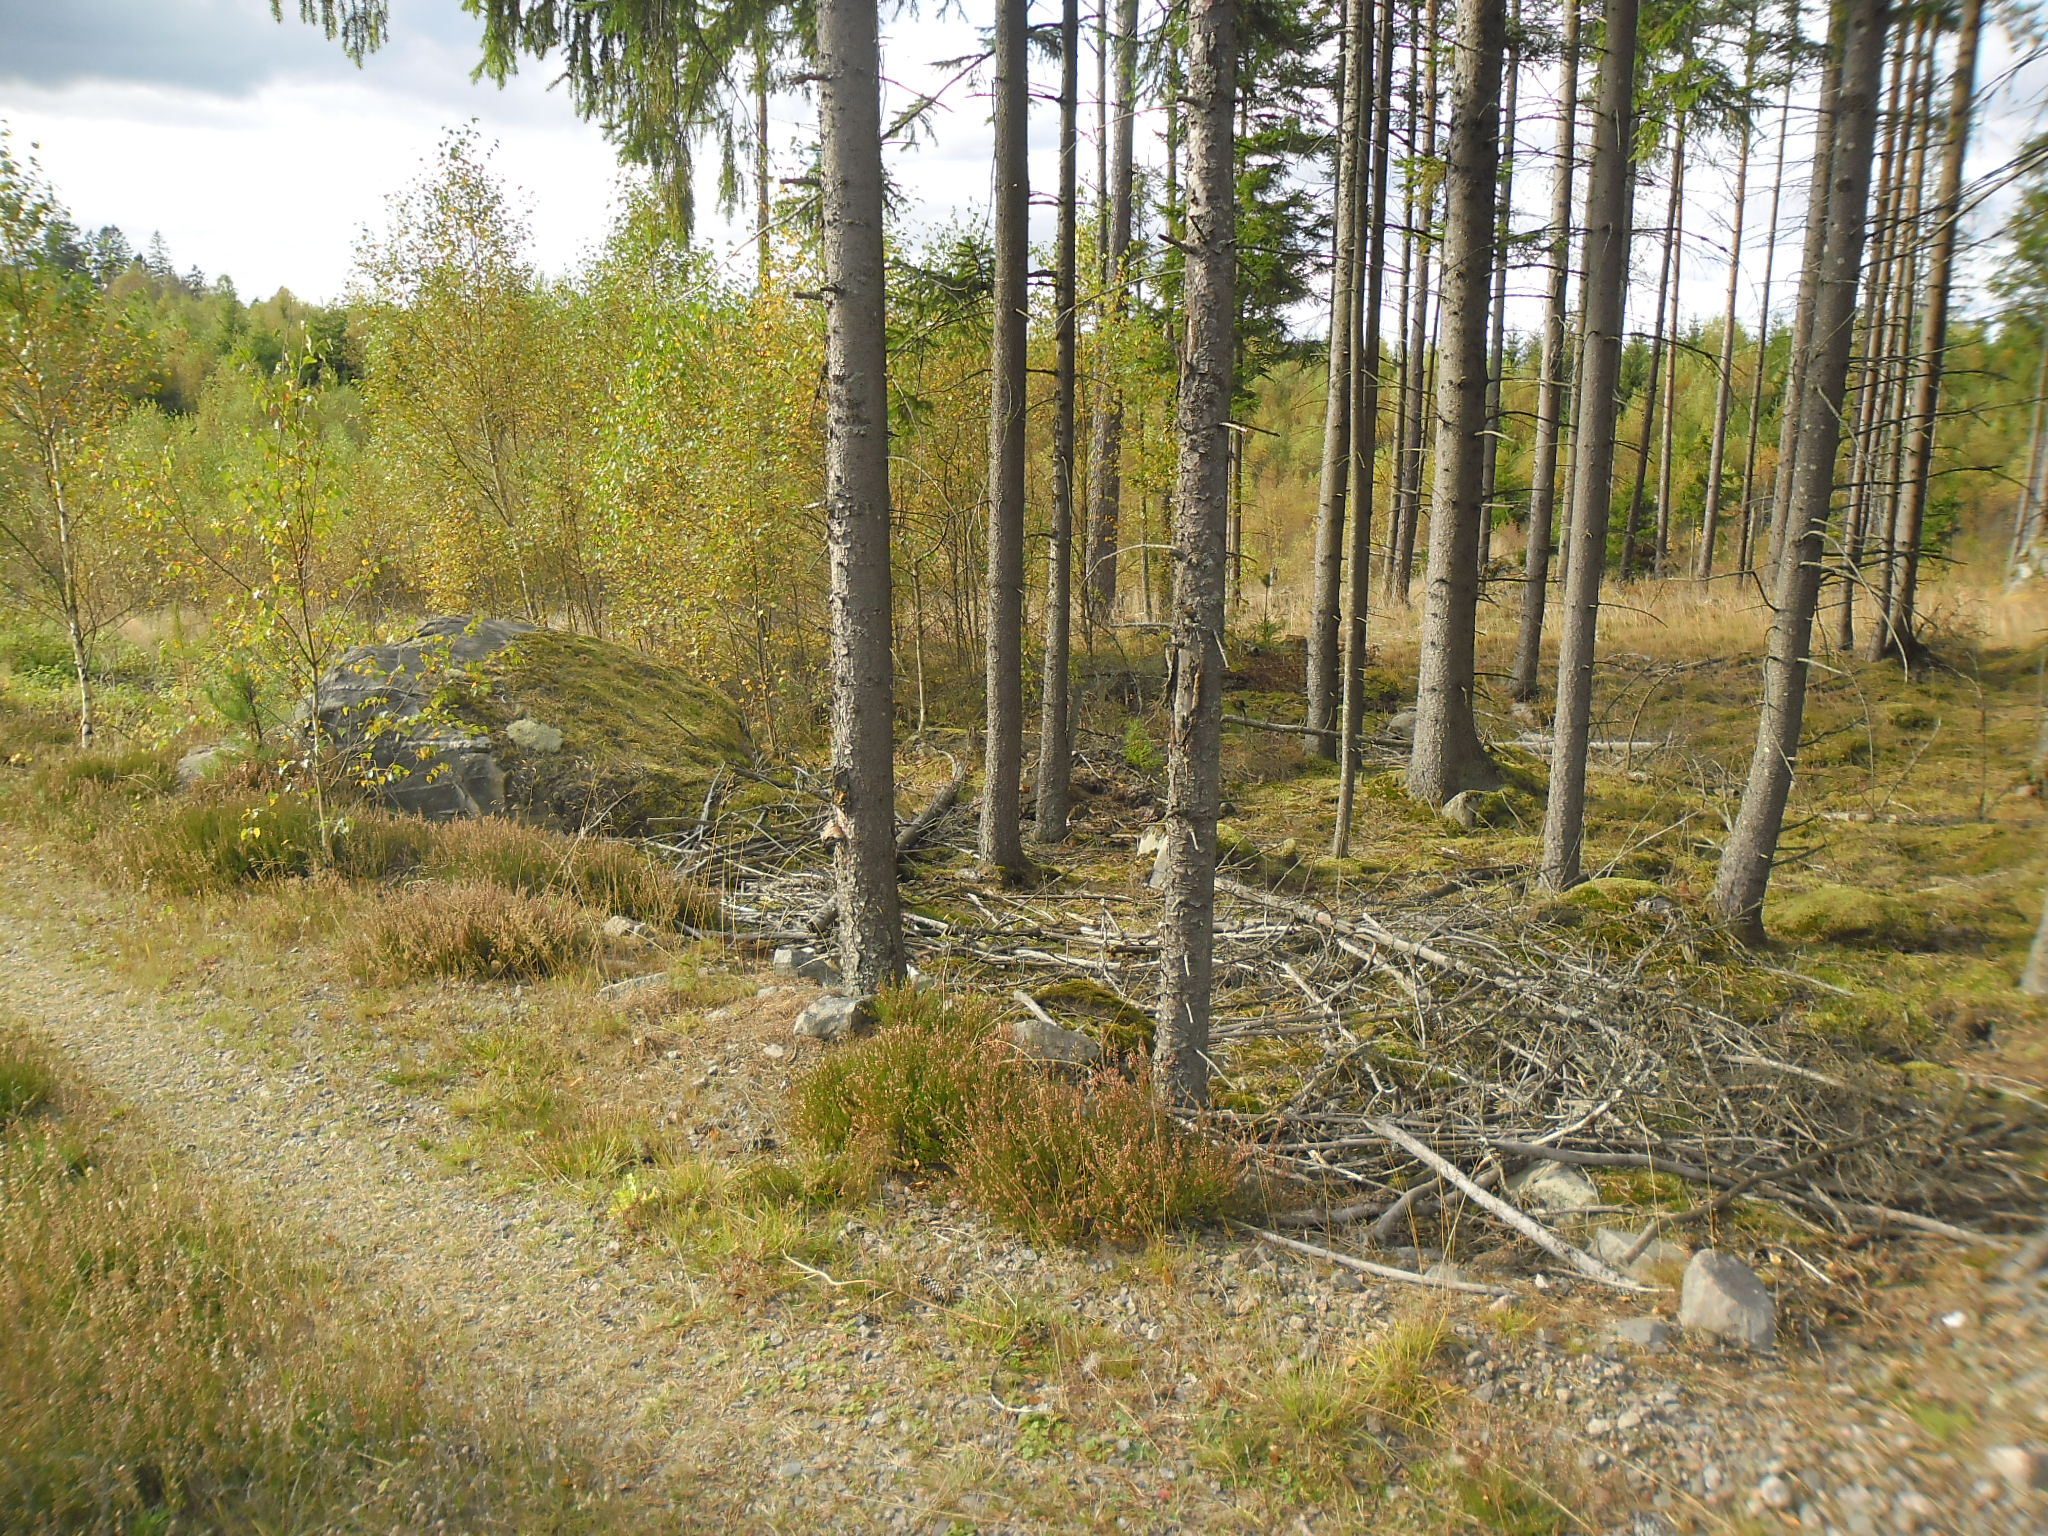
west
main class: Woodland
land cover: Spruce dominated coniferous woodland
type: boreal forest
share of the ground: > 75 %
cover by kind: coniferous forest trees 70 %, herbaceous plants 15 %, lichens and mosses 15 %
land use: Forestry
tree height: > 5 m
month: October
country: SE
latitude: 56.4193
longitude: 13.8067
